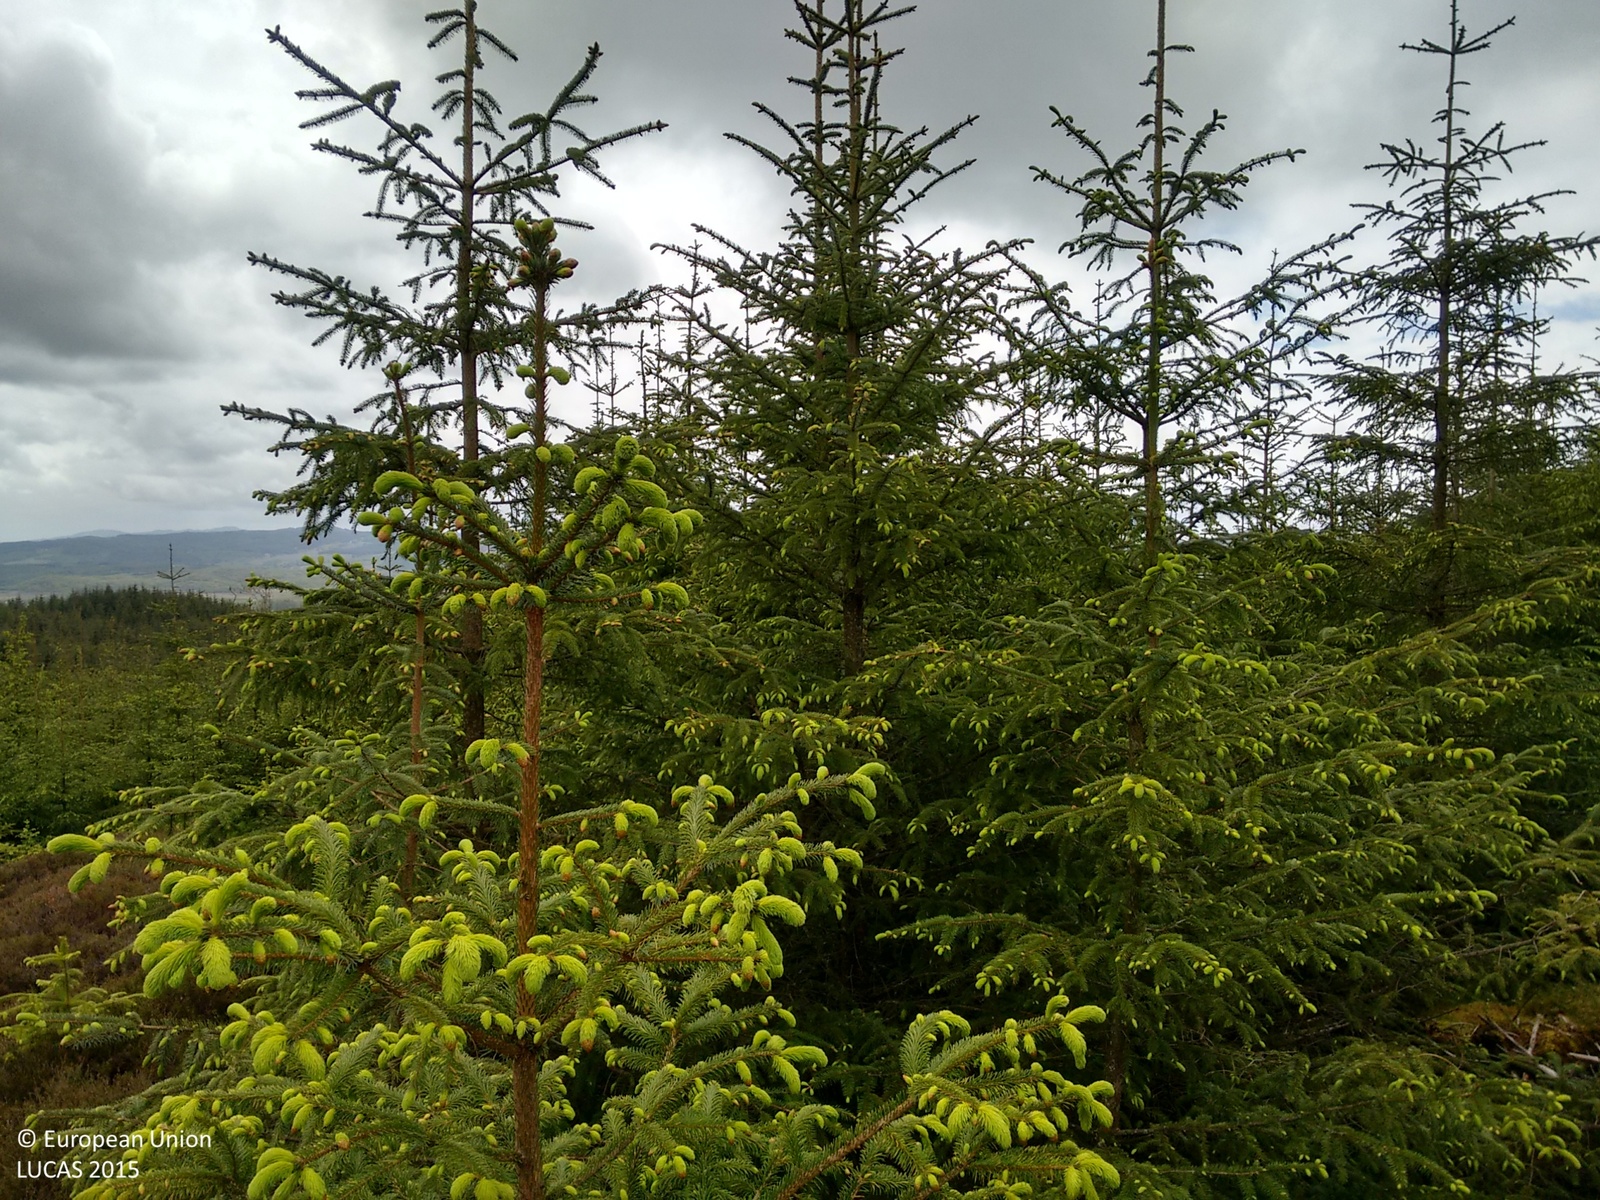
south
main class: Woodland
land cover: Spruce dominated coniferous woodland
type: exotic forest
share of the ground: > 75 %
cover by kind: coniferous forest trees 100 %
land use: Forestry
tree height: > 5 m
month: June
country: GB
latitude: 56.1205
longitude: -5.4825
